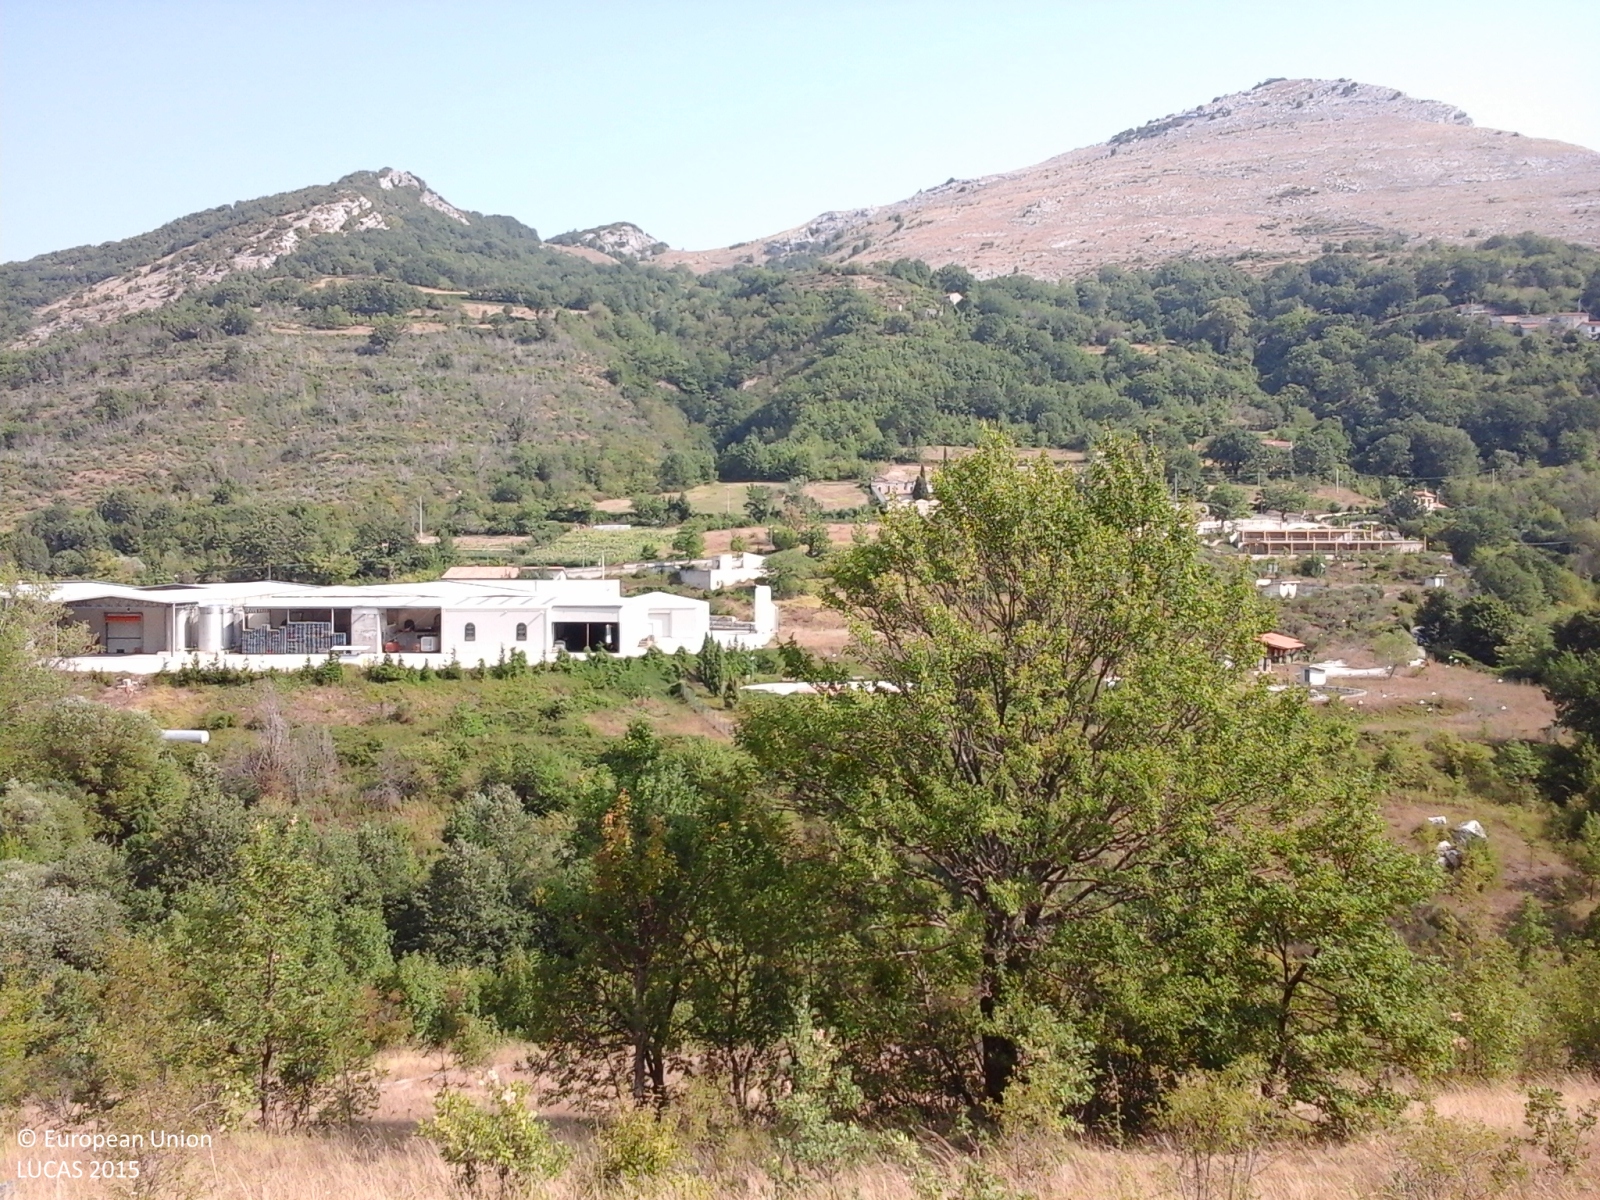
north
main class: Woodland
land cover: Broadleaved woodland
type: thermophilous deciduous forest
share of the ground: > 75 %
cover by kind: broadleaved forest trees 90 %, shrubs 5 %, herbaceous plants 5 %
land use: Semi-natural and natural areas not in use
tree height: > 5 m
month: August
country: IT
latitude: 41.5140
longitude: 14.2860
